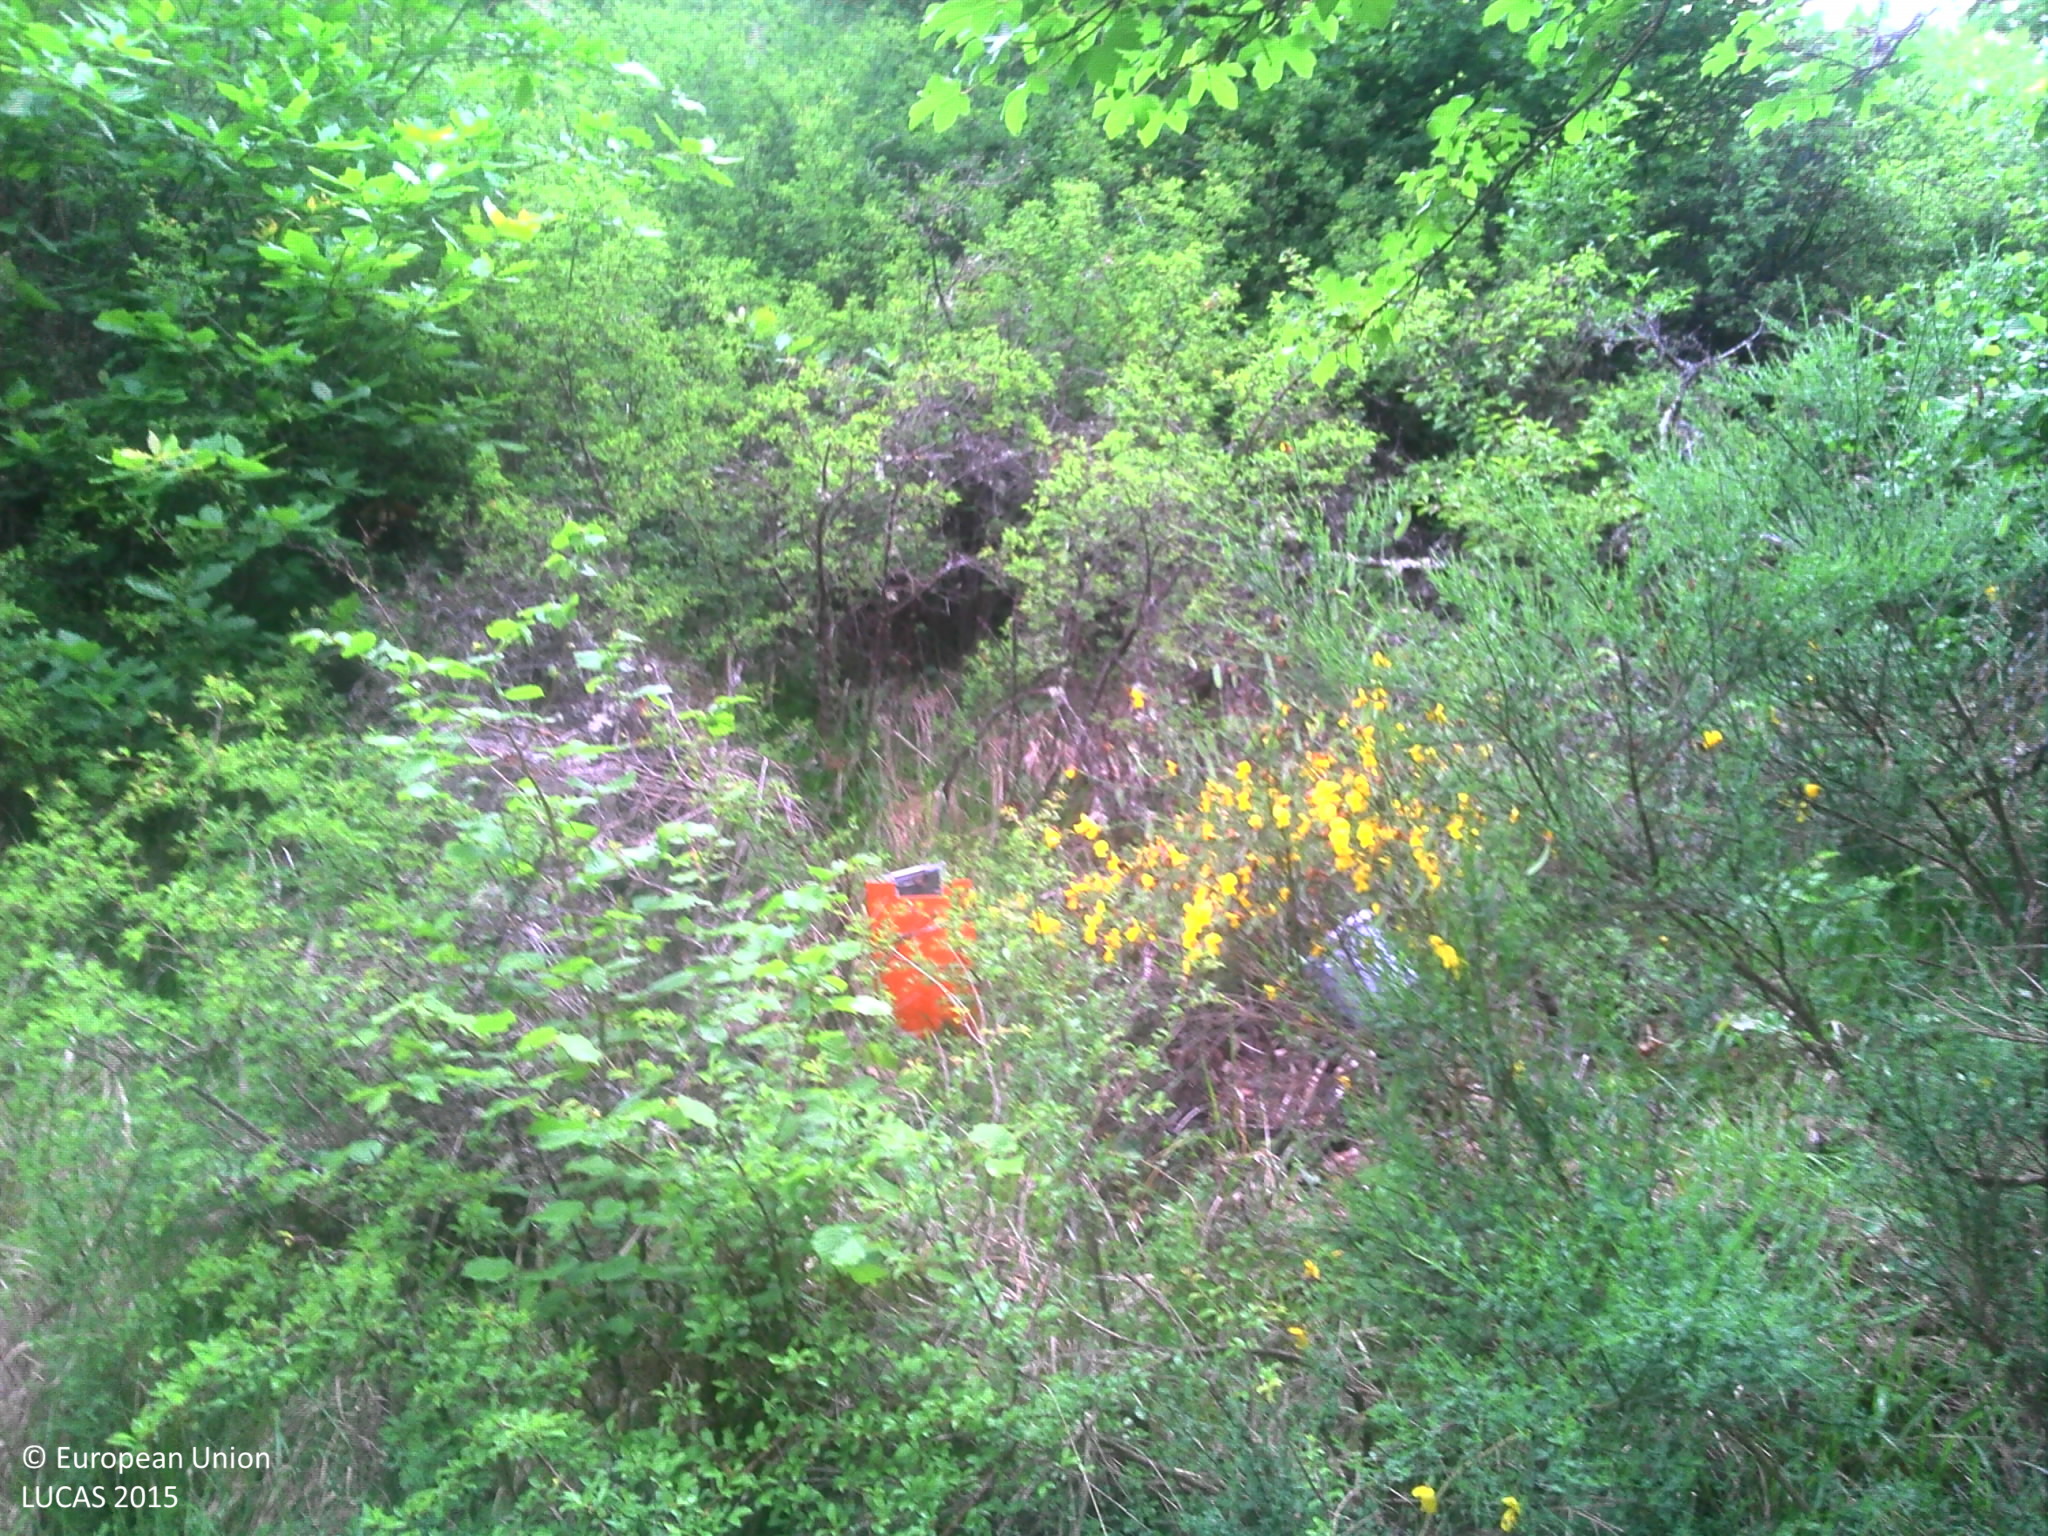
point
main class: Shrubland
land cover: Shrubland with sparse tree cover
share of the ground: > 75 %
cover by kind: shrubs 85 %, herbaceous plants 10 %, broadleaved forest trees 5 %
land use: Semi-natural and natural areas not in use
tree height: > 5 m
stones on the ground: < 10 %
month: June
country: FR
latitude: 45.1583
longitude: 3.1964
